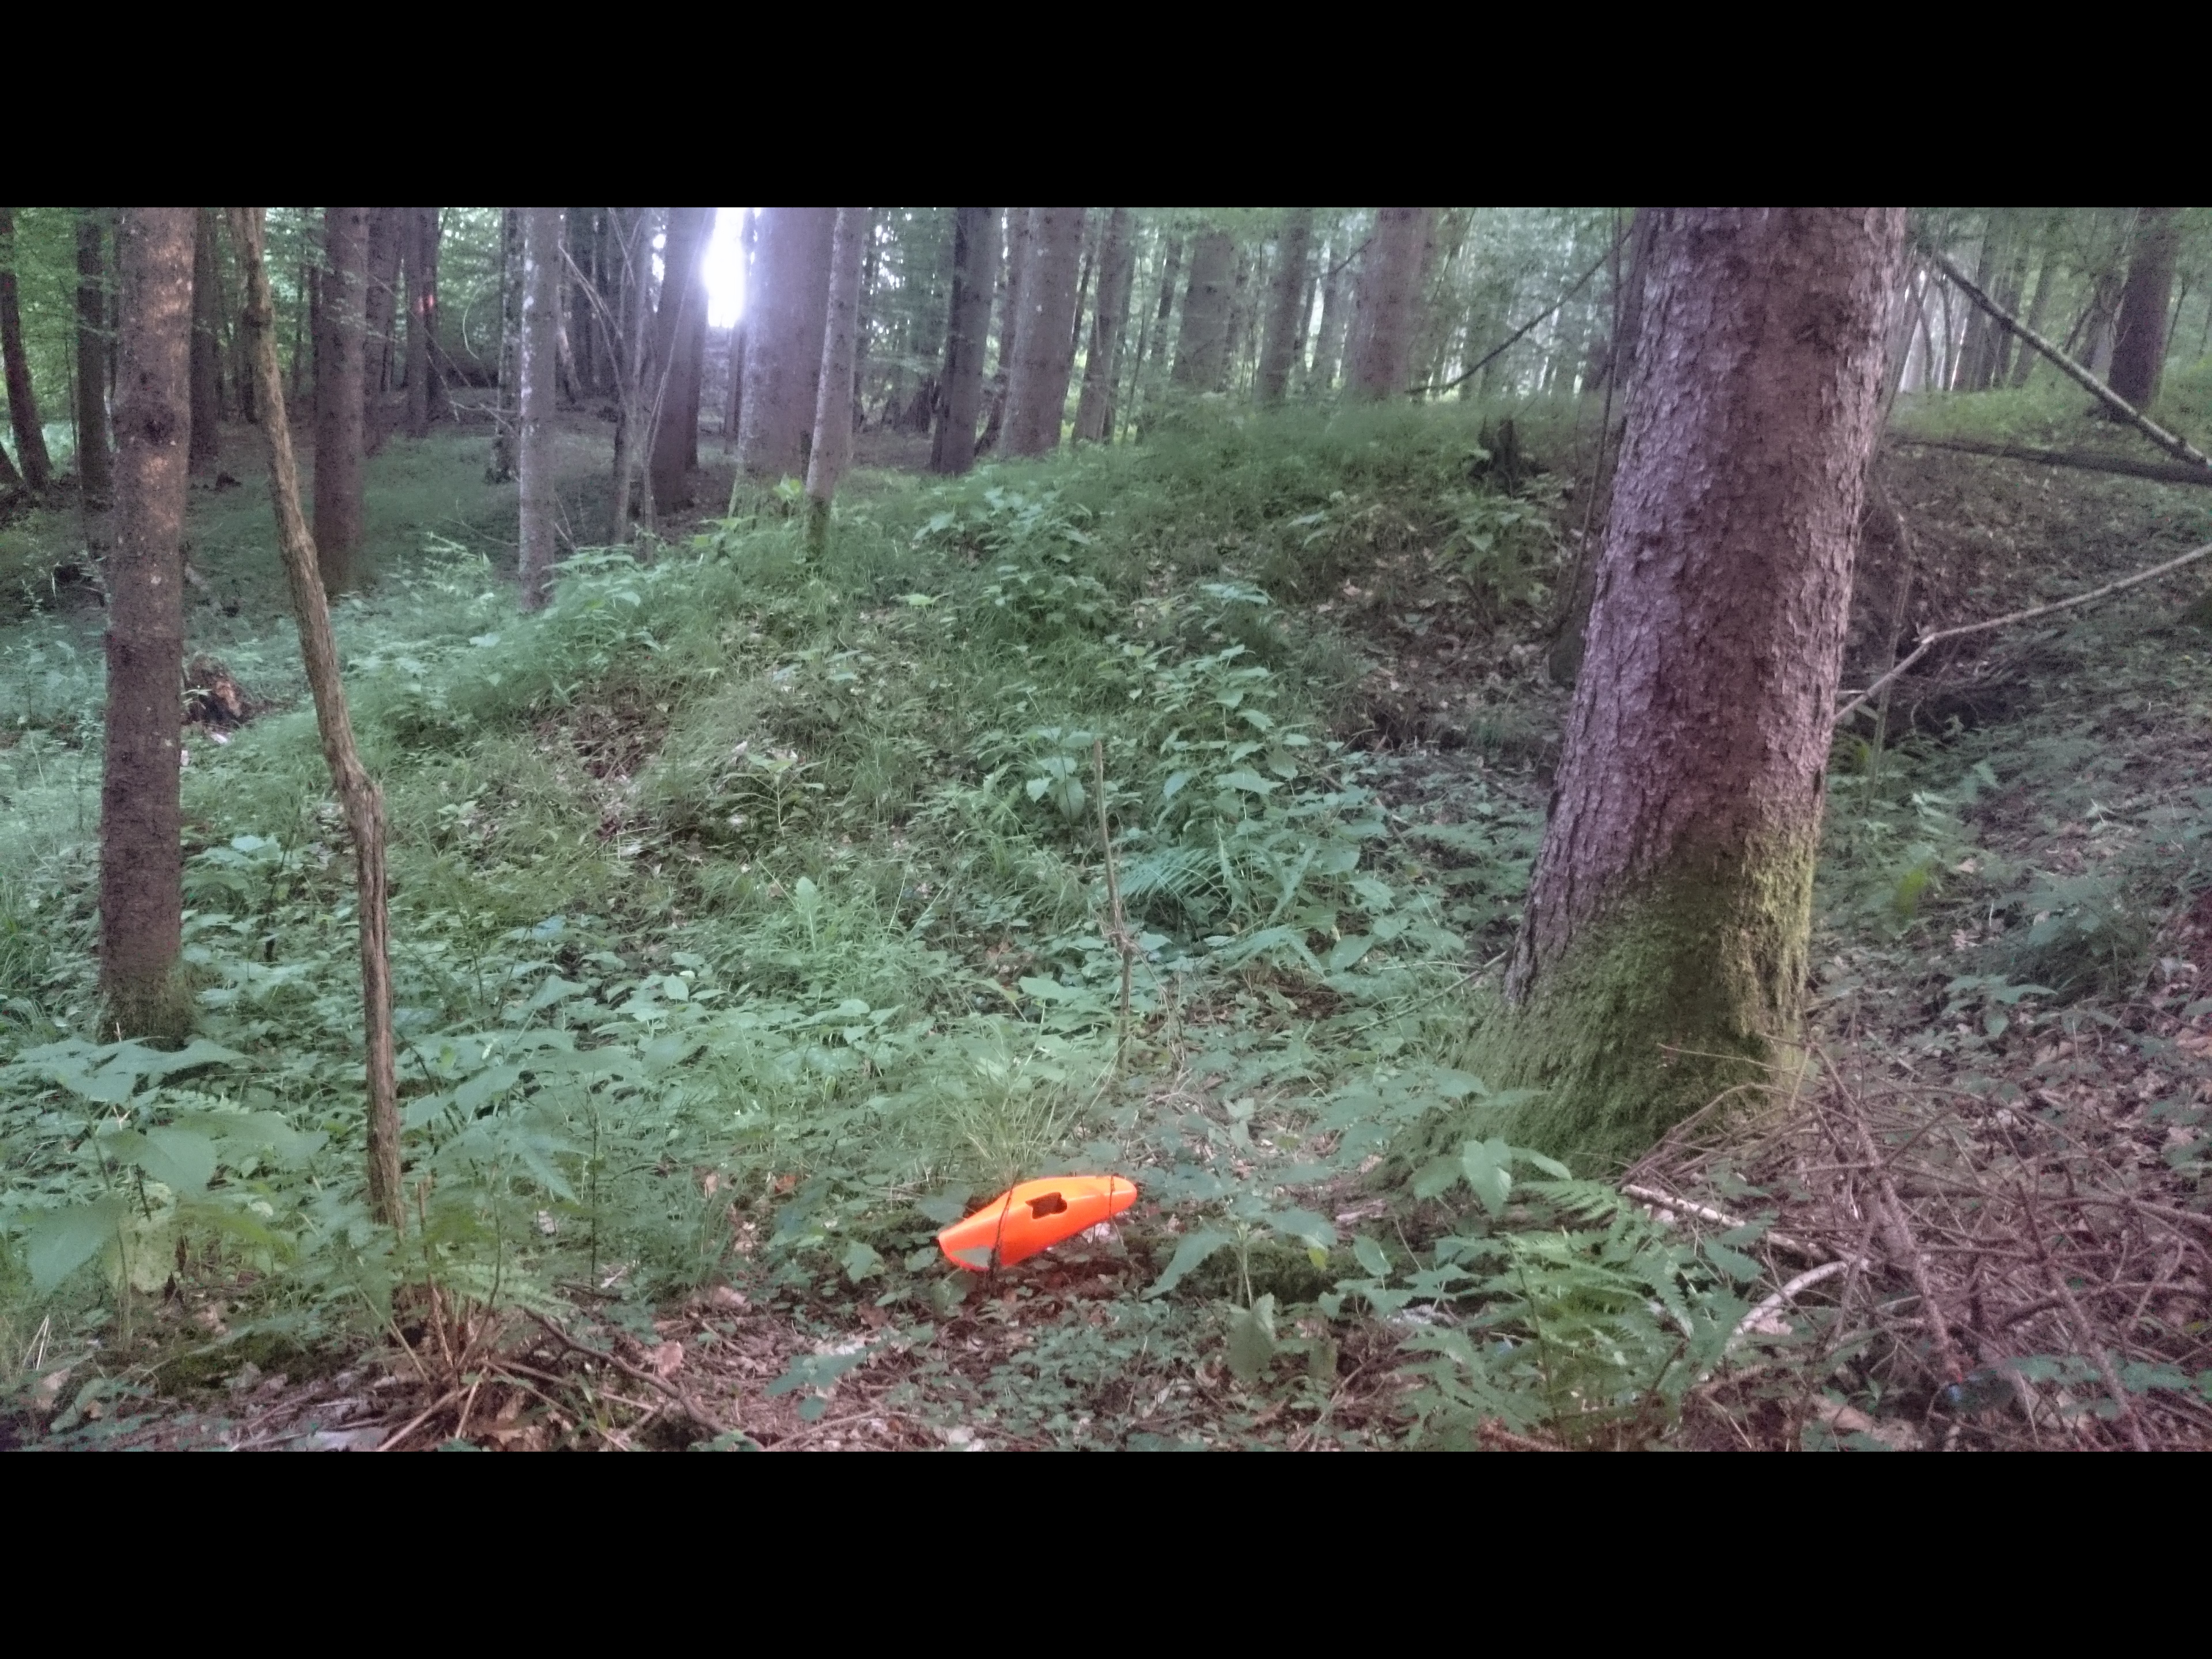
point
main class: Woodland
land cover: Spruce dominated mixed woodland
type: hemiboreal forest and nemoral coniferous forest and mixed broadleaved-coniferous forest
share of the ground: > 75 %
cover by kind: coniferous forest trees 45 %, broadleaved forest trees 45 %, herbaceous plants 10 %
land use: Forestry
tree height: > 5 m
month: July
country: AT
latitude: 47.2285
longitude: 15.6932
